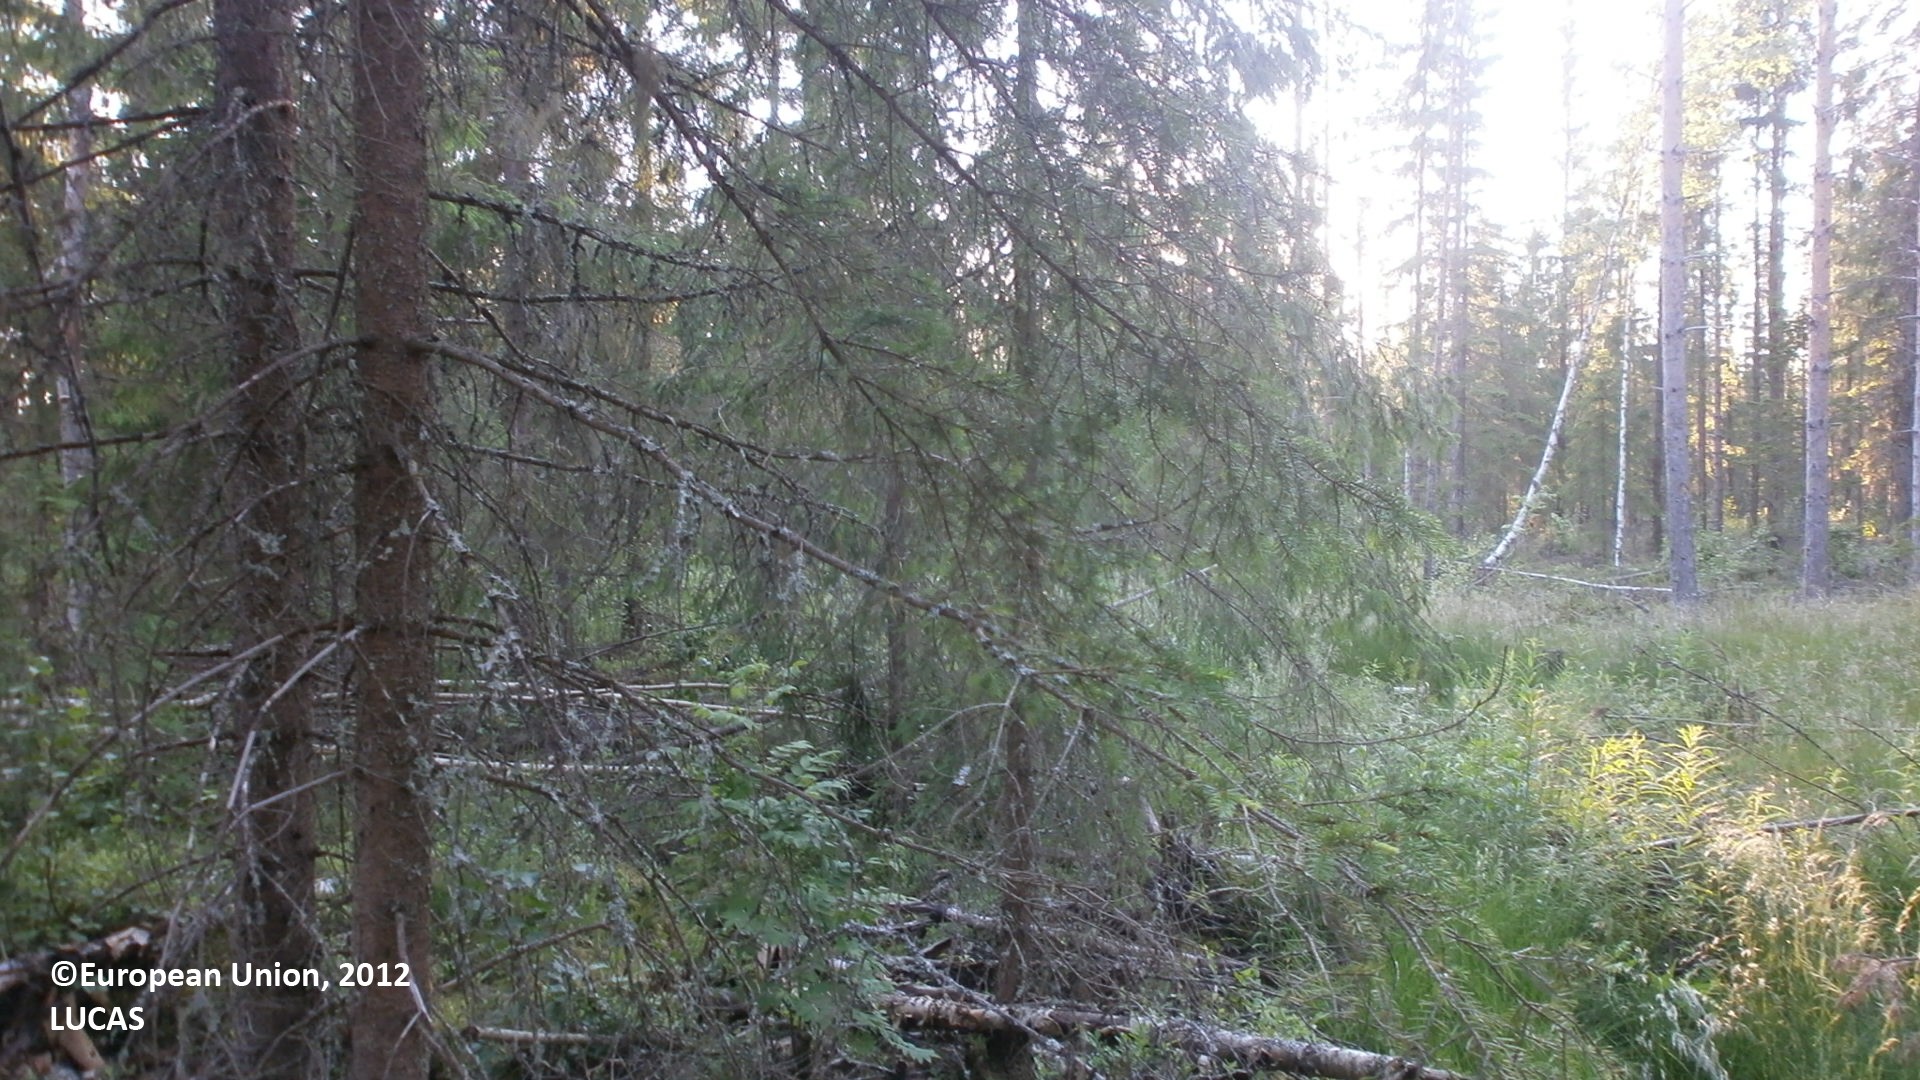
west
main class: Woodland
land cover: Spruce dominated coniferous woodland
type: boreal forest
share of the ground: 50 - 75 %
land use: Forestry
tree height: > 5 m
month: July
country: FI
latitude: 64.0700
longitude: 24.7758
